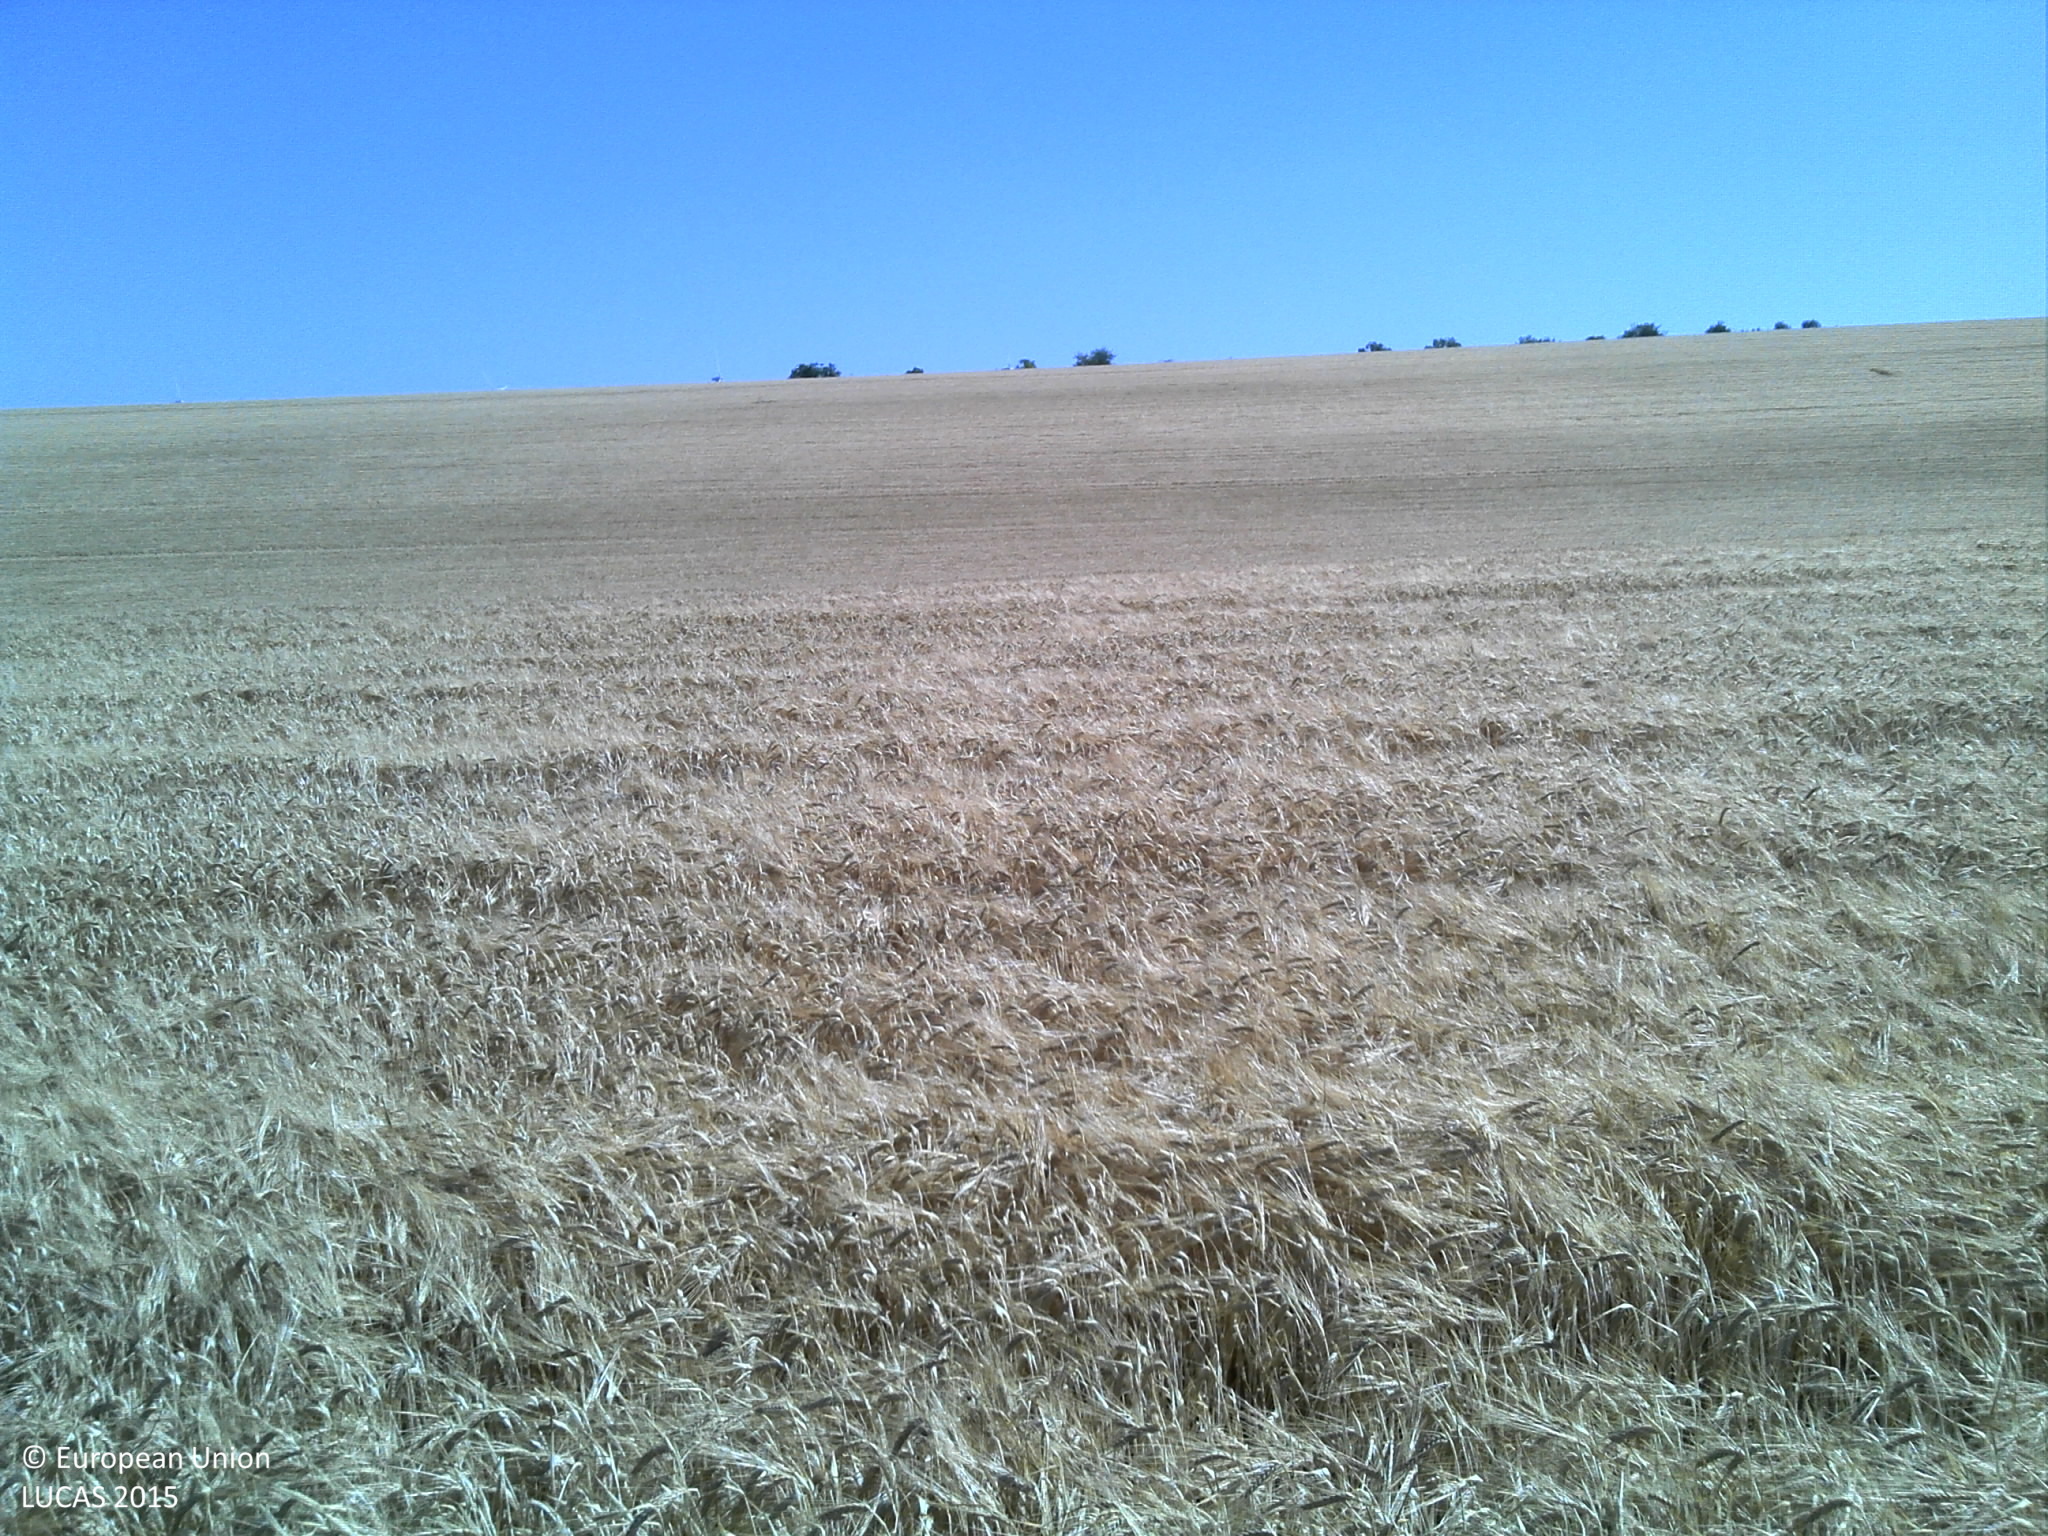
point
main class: Cropland
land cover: Barley
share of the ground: > 75 %
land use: Agriculture (excluding fallow land and kitchen gardens)
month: July
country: FR
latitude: 48.8685
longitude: 4.6394
